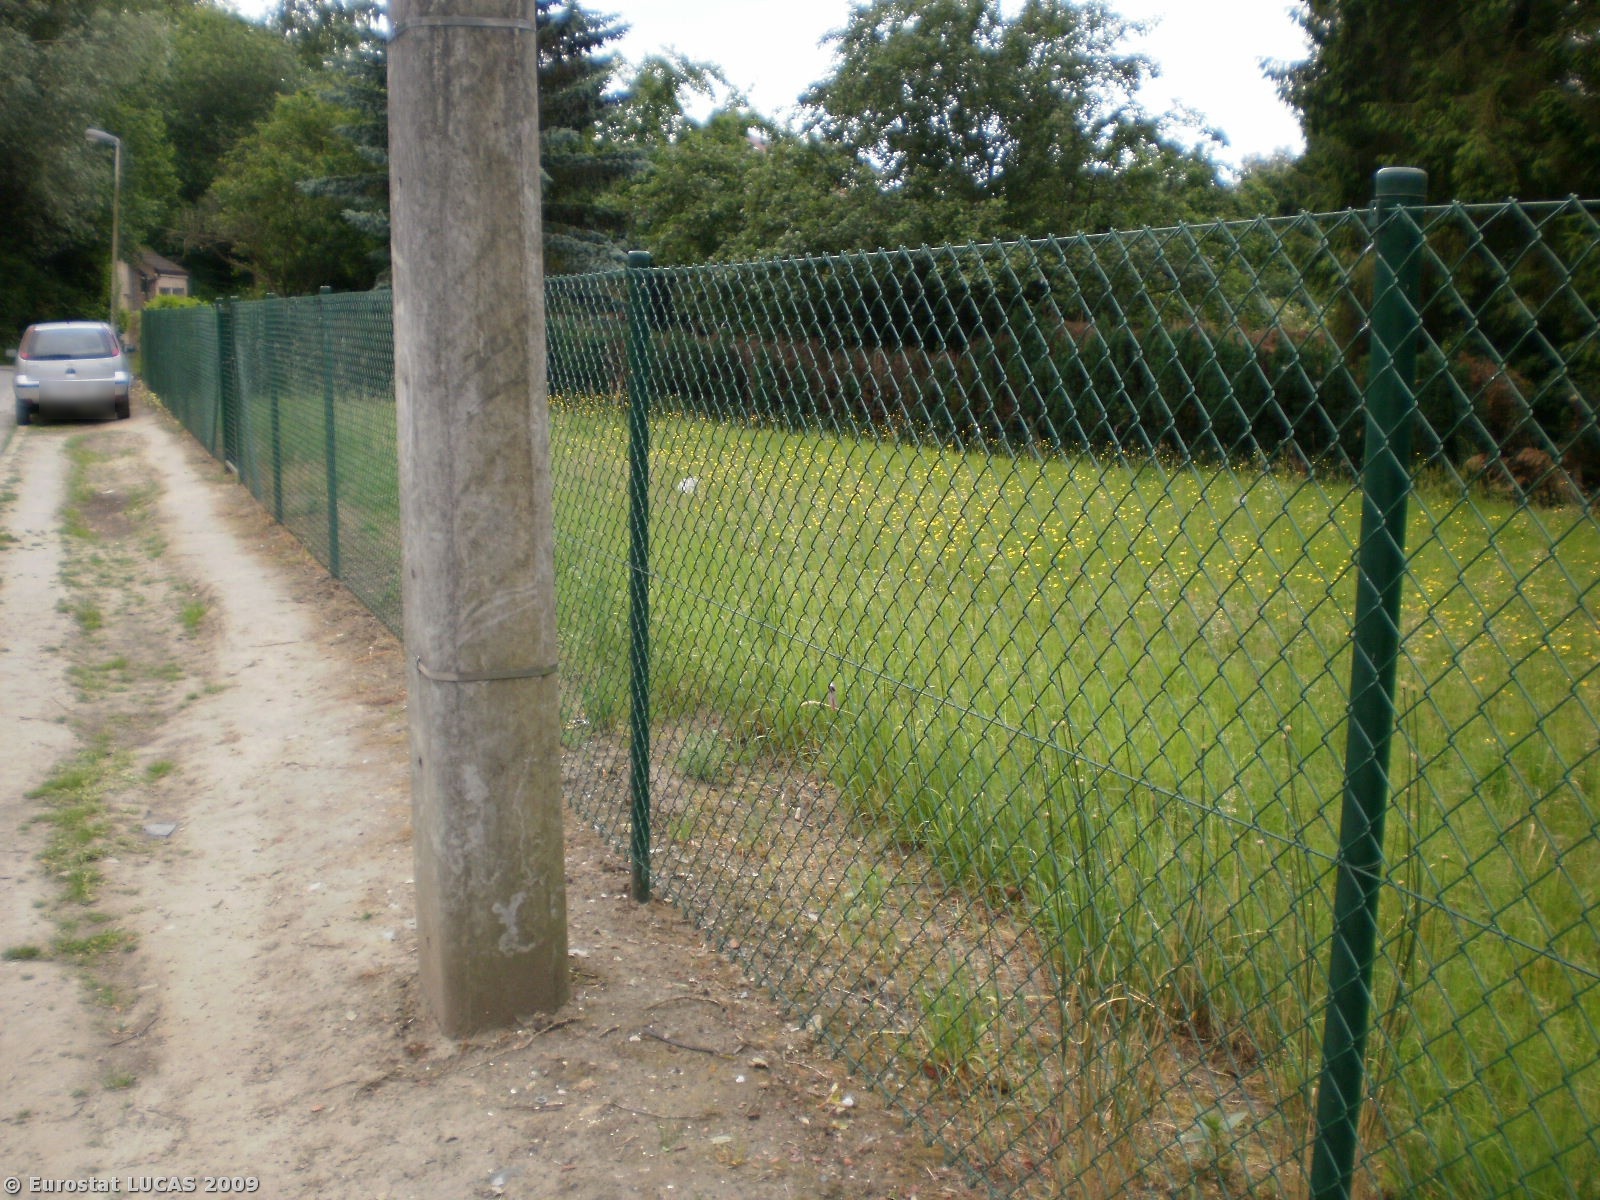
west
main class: Grassland
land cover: Grassland without tree/shrub cover
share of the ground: > 75 %
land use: Agriculture (excluding fallow land and kitchen gardens)
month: June
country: BE
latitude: 50.7122
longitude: 4.3731
